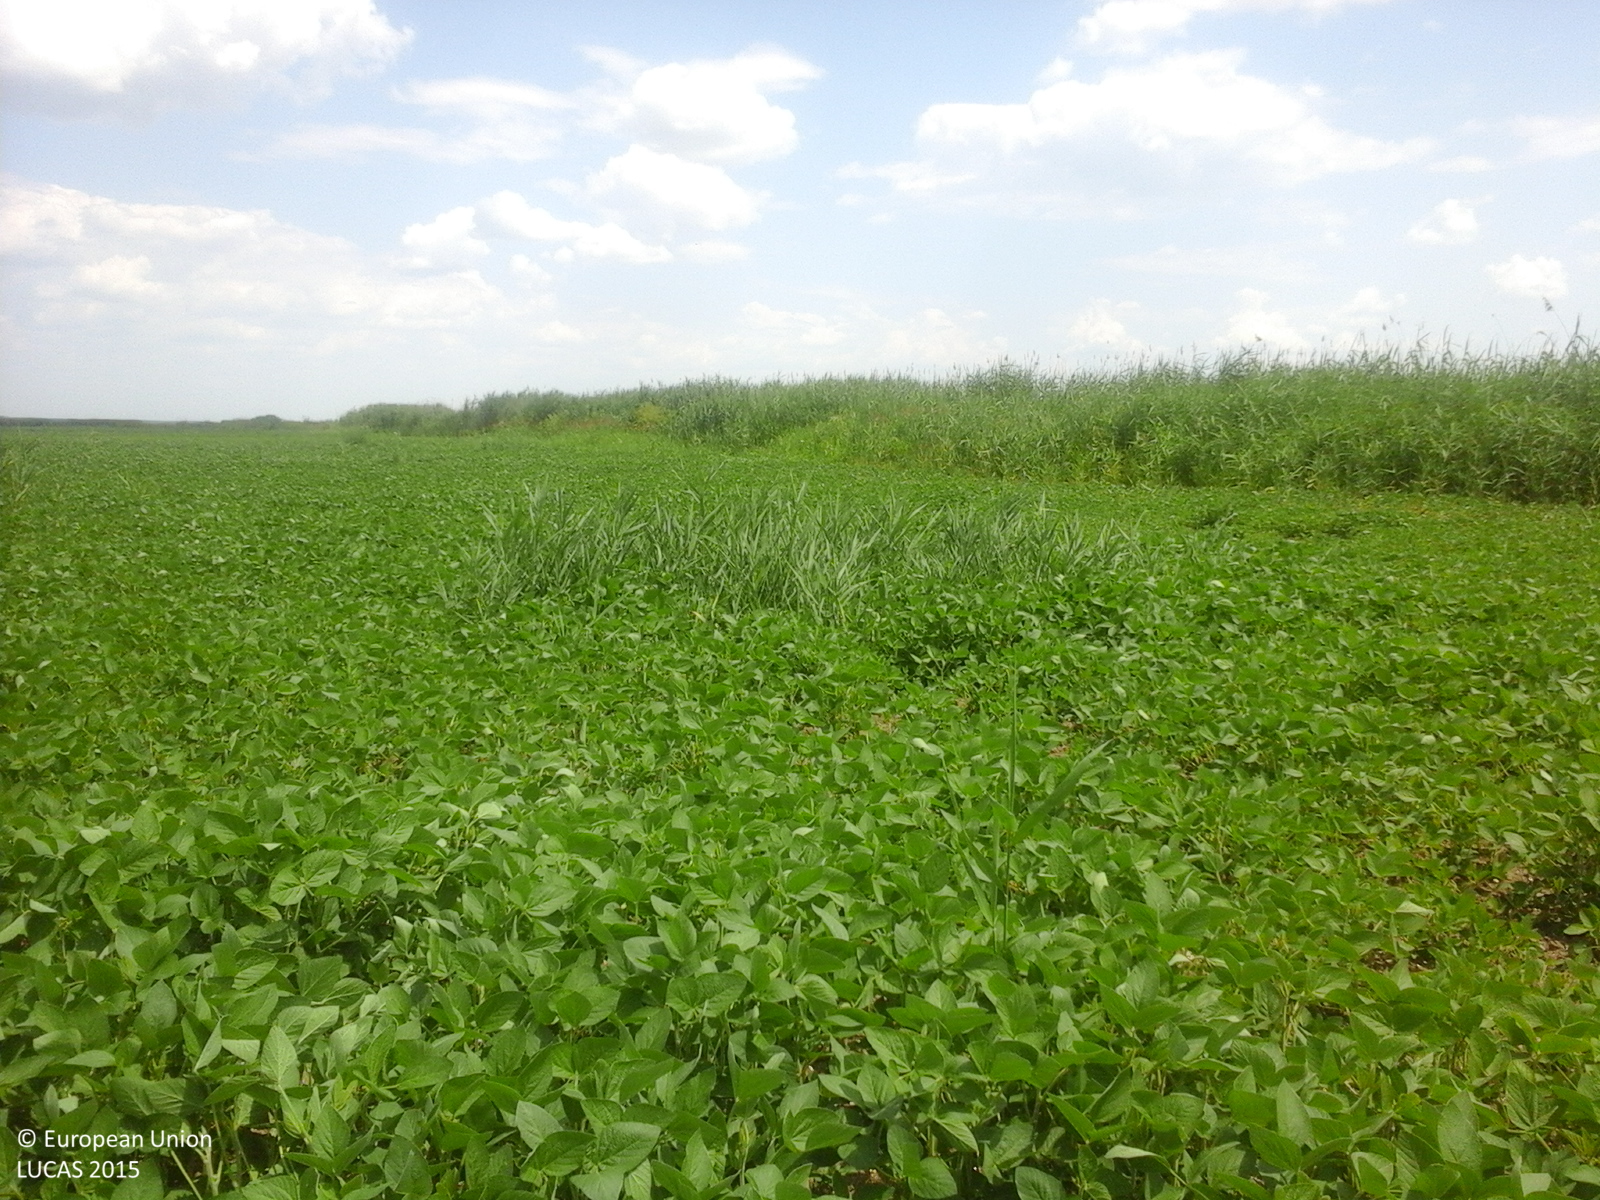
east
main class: Cropland
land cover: Soya
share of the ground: > 75 %
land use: Agriculture (excluding fallow land and kitchen gardens)
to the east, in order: Soya; Lucerne; Ponds and wetlands; Ditches and canals; Ponds and wetlands; Soya
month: June
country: RO
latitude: 44.0893
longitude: 26.3567
